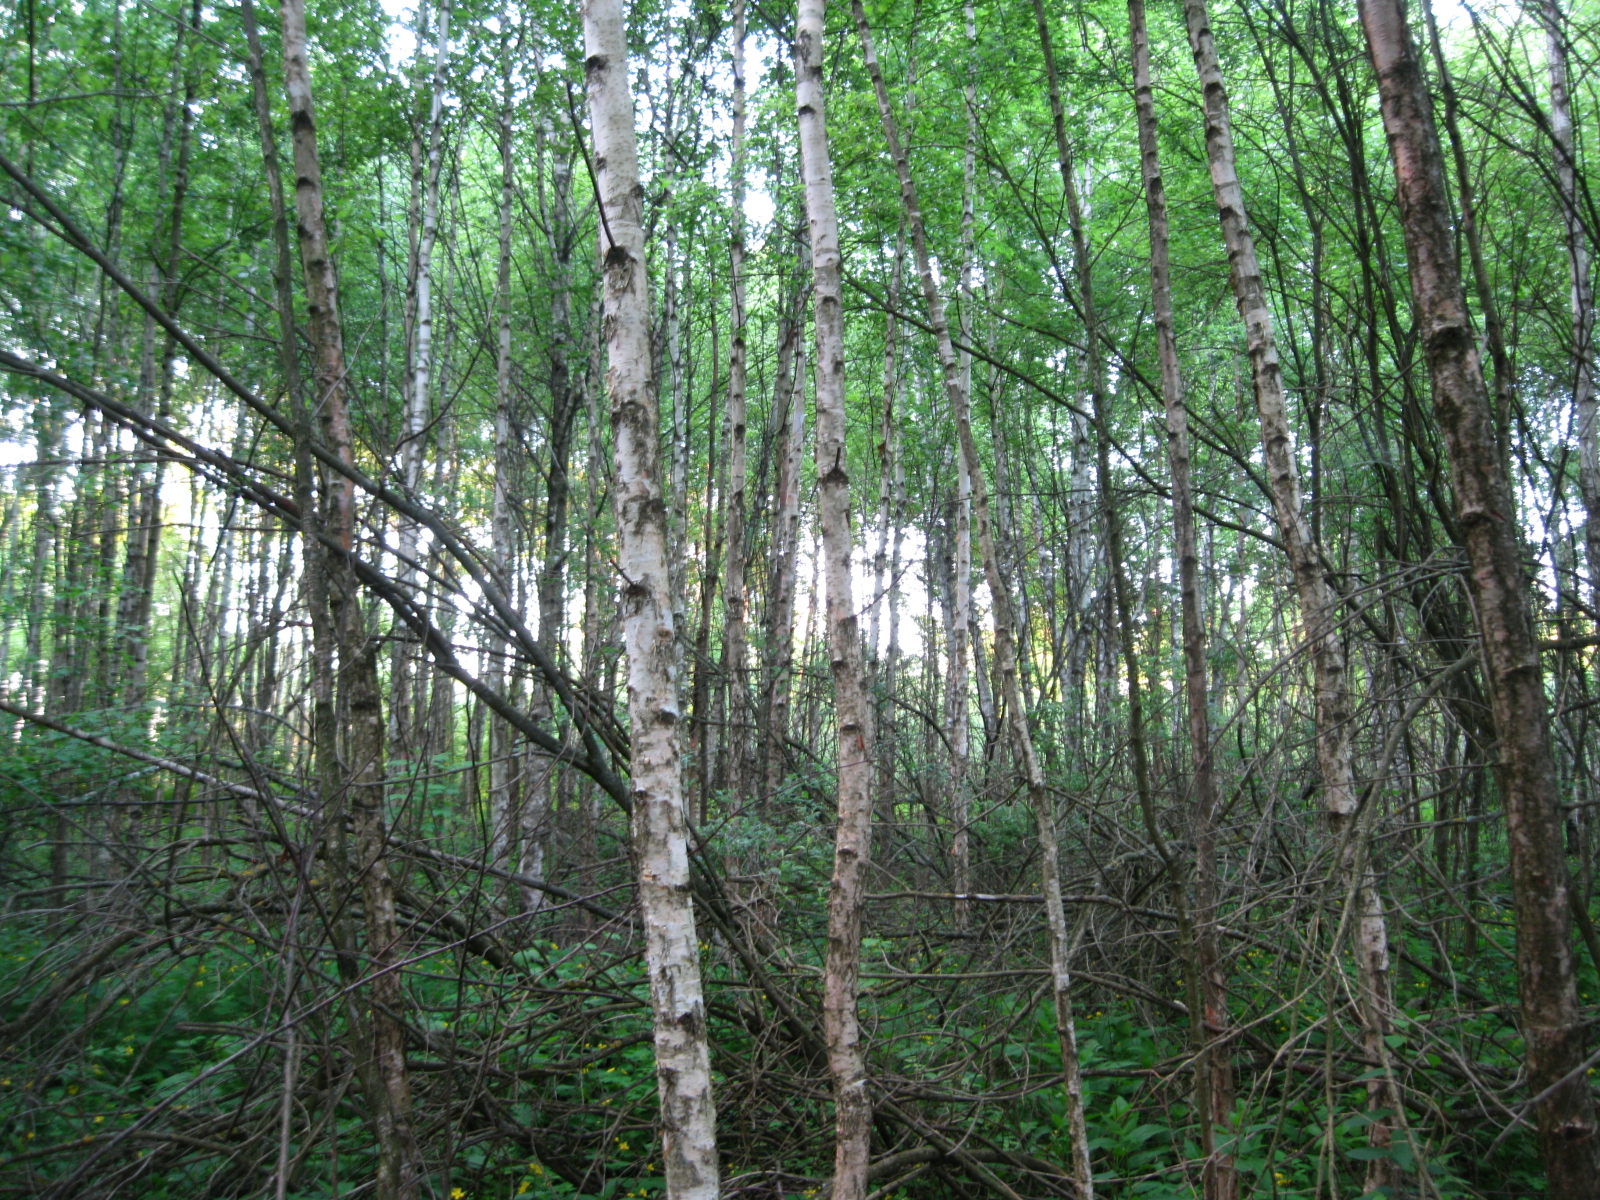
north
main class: Woodland
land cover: Broadleaved woodland
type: non-riverine alder, birch or aspen forest
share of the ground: > 75 %
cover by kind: broadleaved forest trees 85 %, herbaceous plants 15 %
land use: Semi-natural and natural areas not in use
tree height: > 5 m
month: May
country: LT
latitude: 55.9431
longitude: 24.8201
